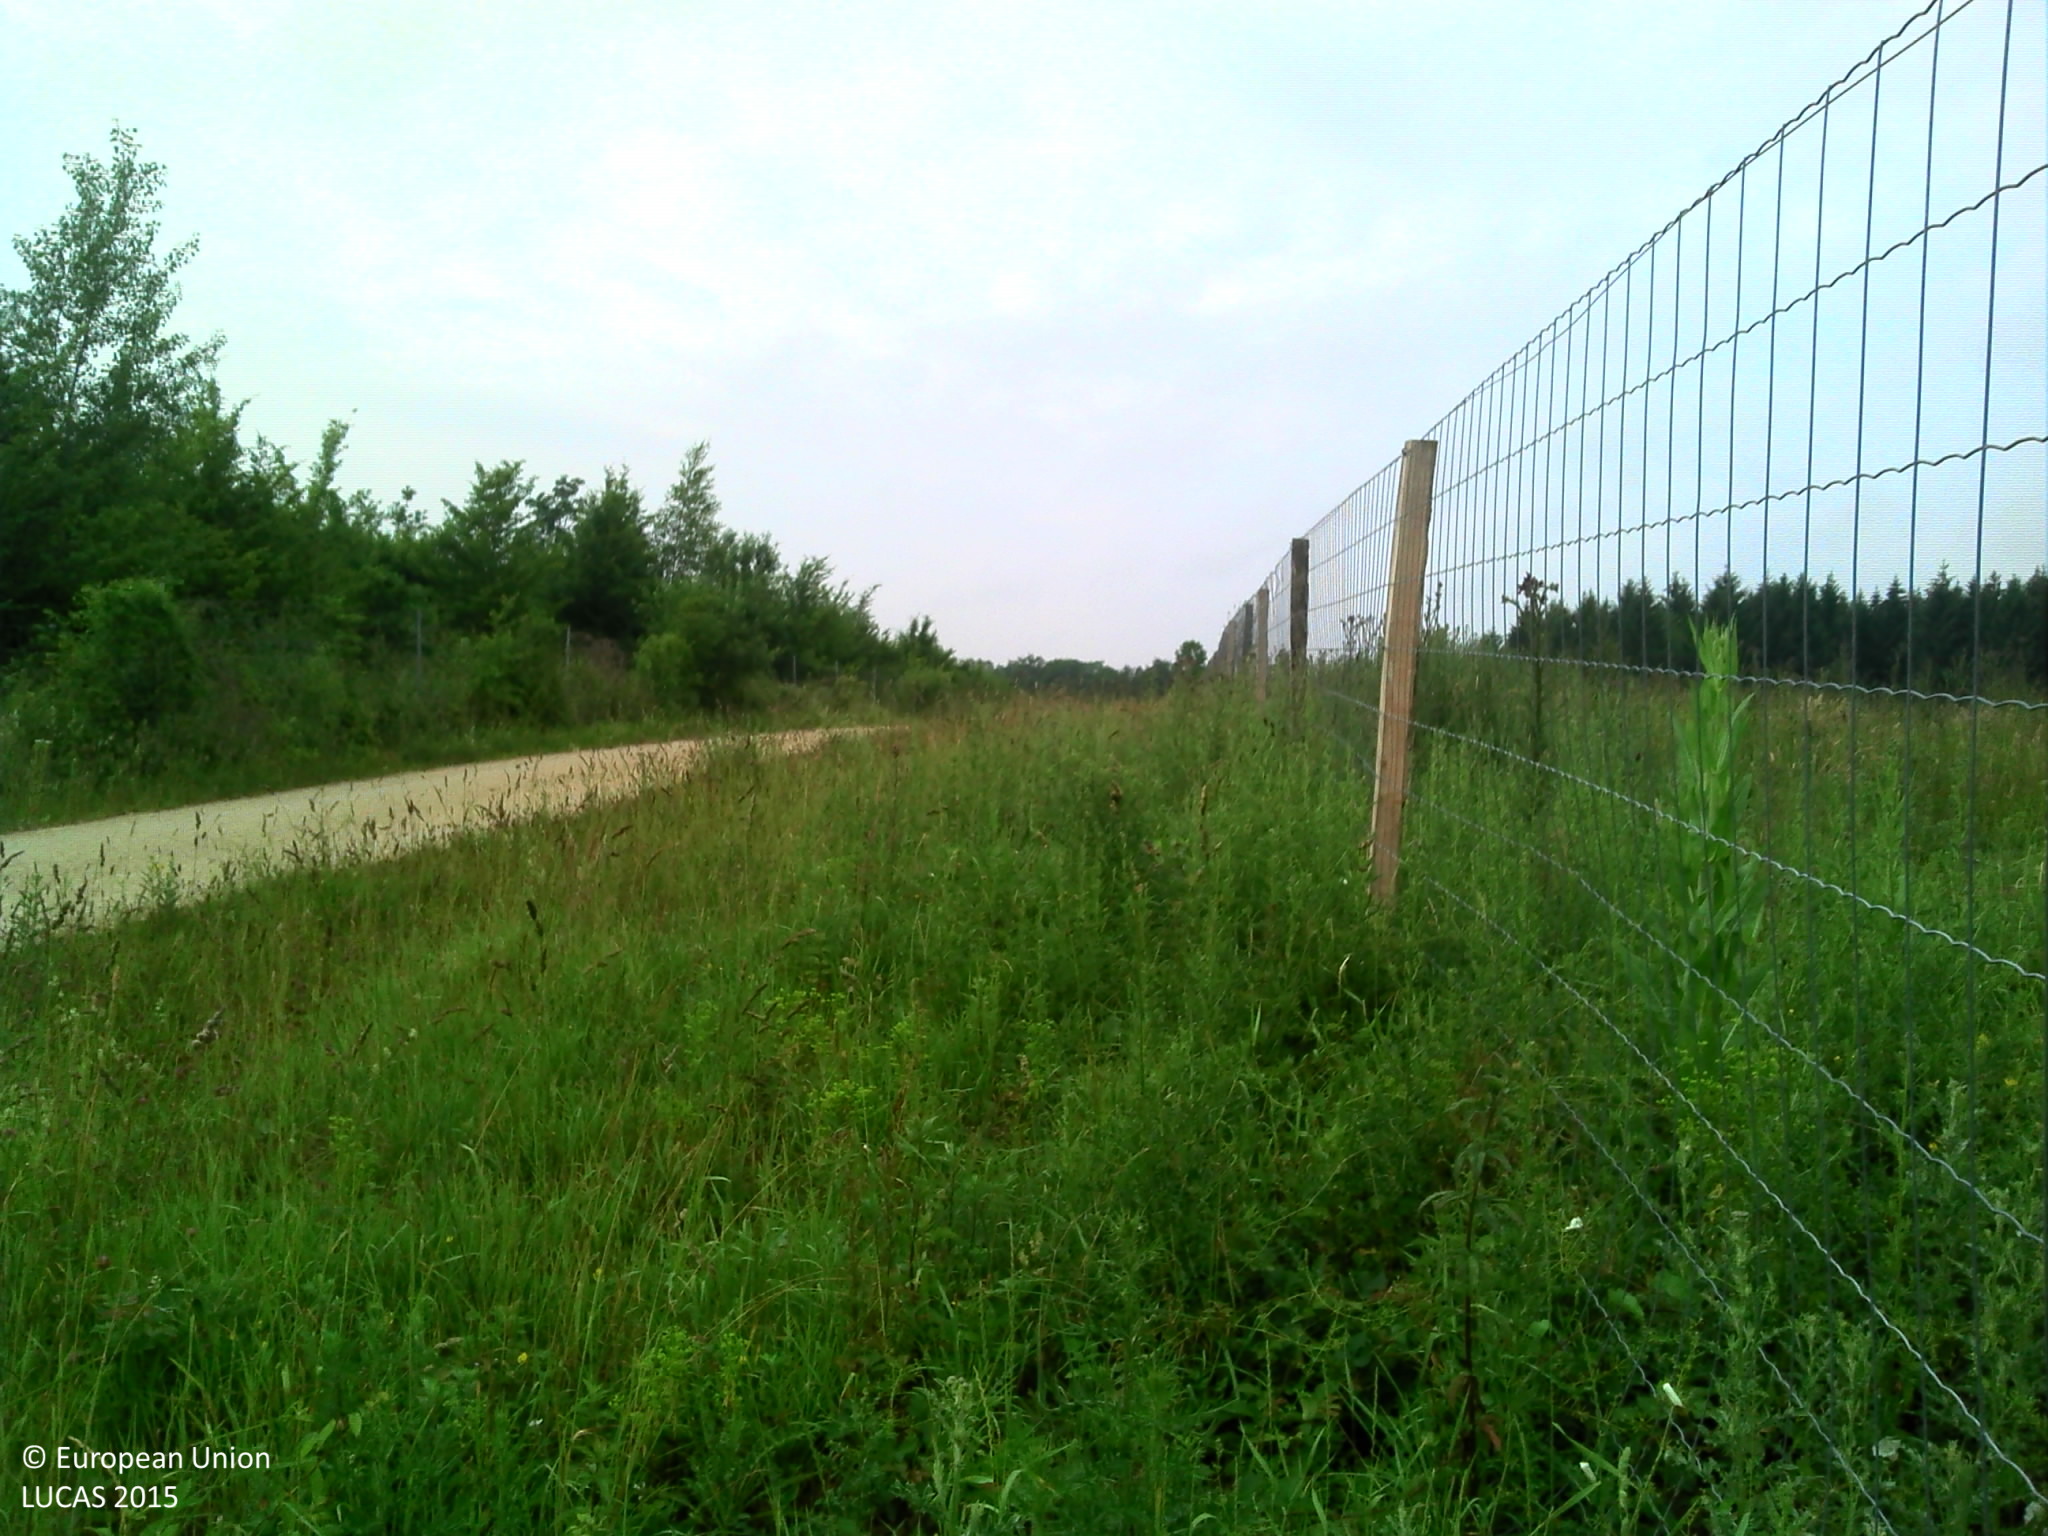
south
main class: Grassland
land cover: Spontaneously vegetated surfaces
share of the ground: 50 - 75 %
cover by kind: herbaceous plants 80 %, consolidated bare surface 20 %
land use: Forestry
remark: Clear cut
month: June
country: FR
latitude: 48.2149
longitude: 4.9248
